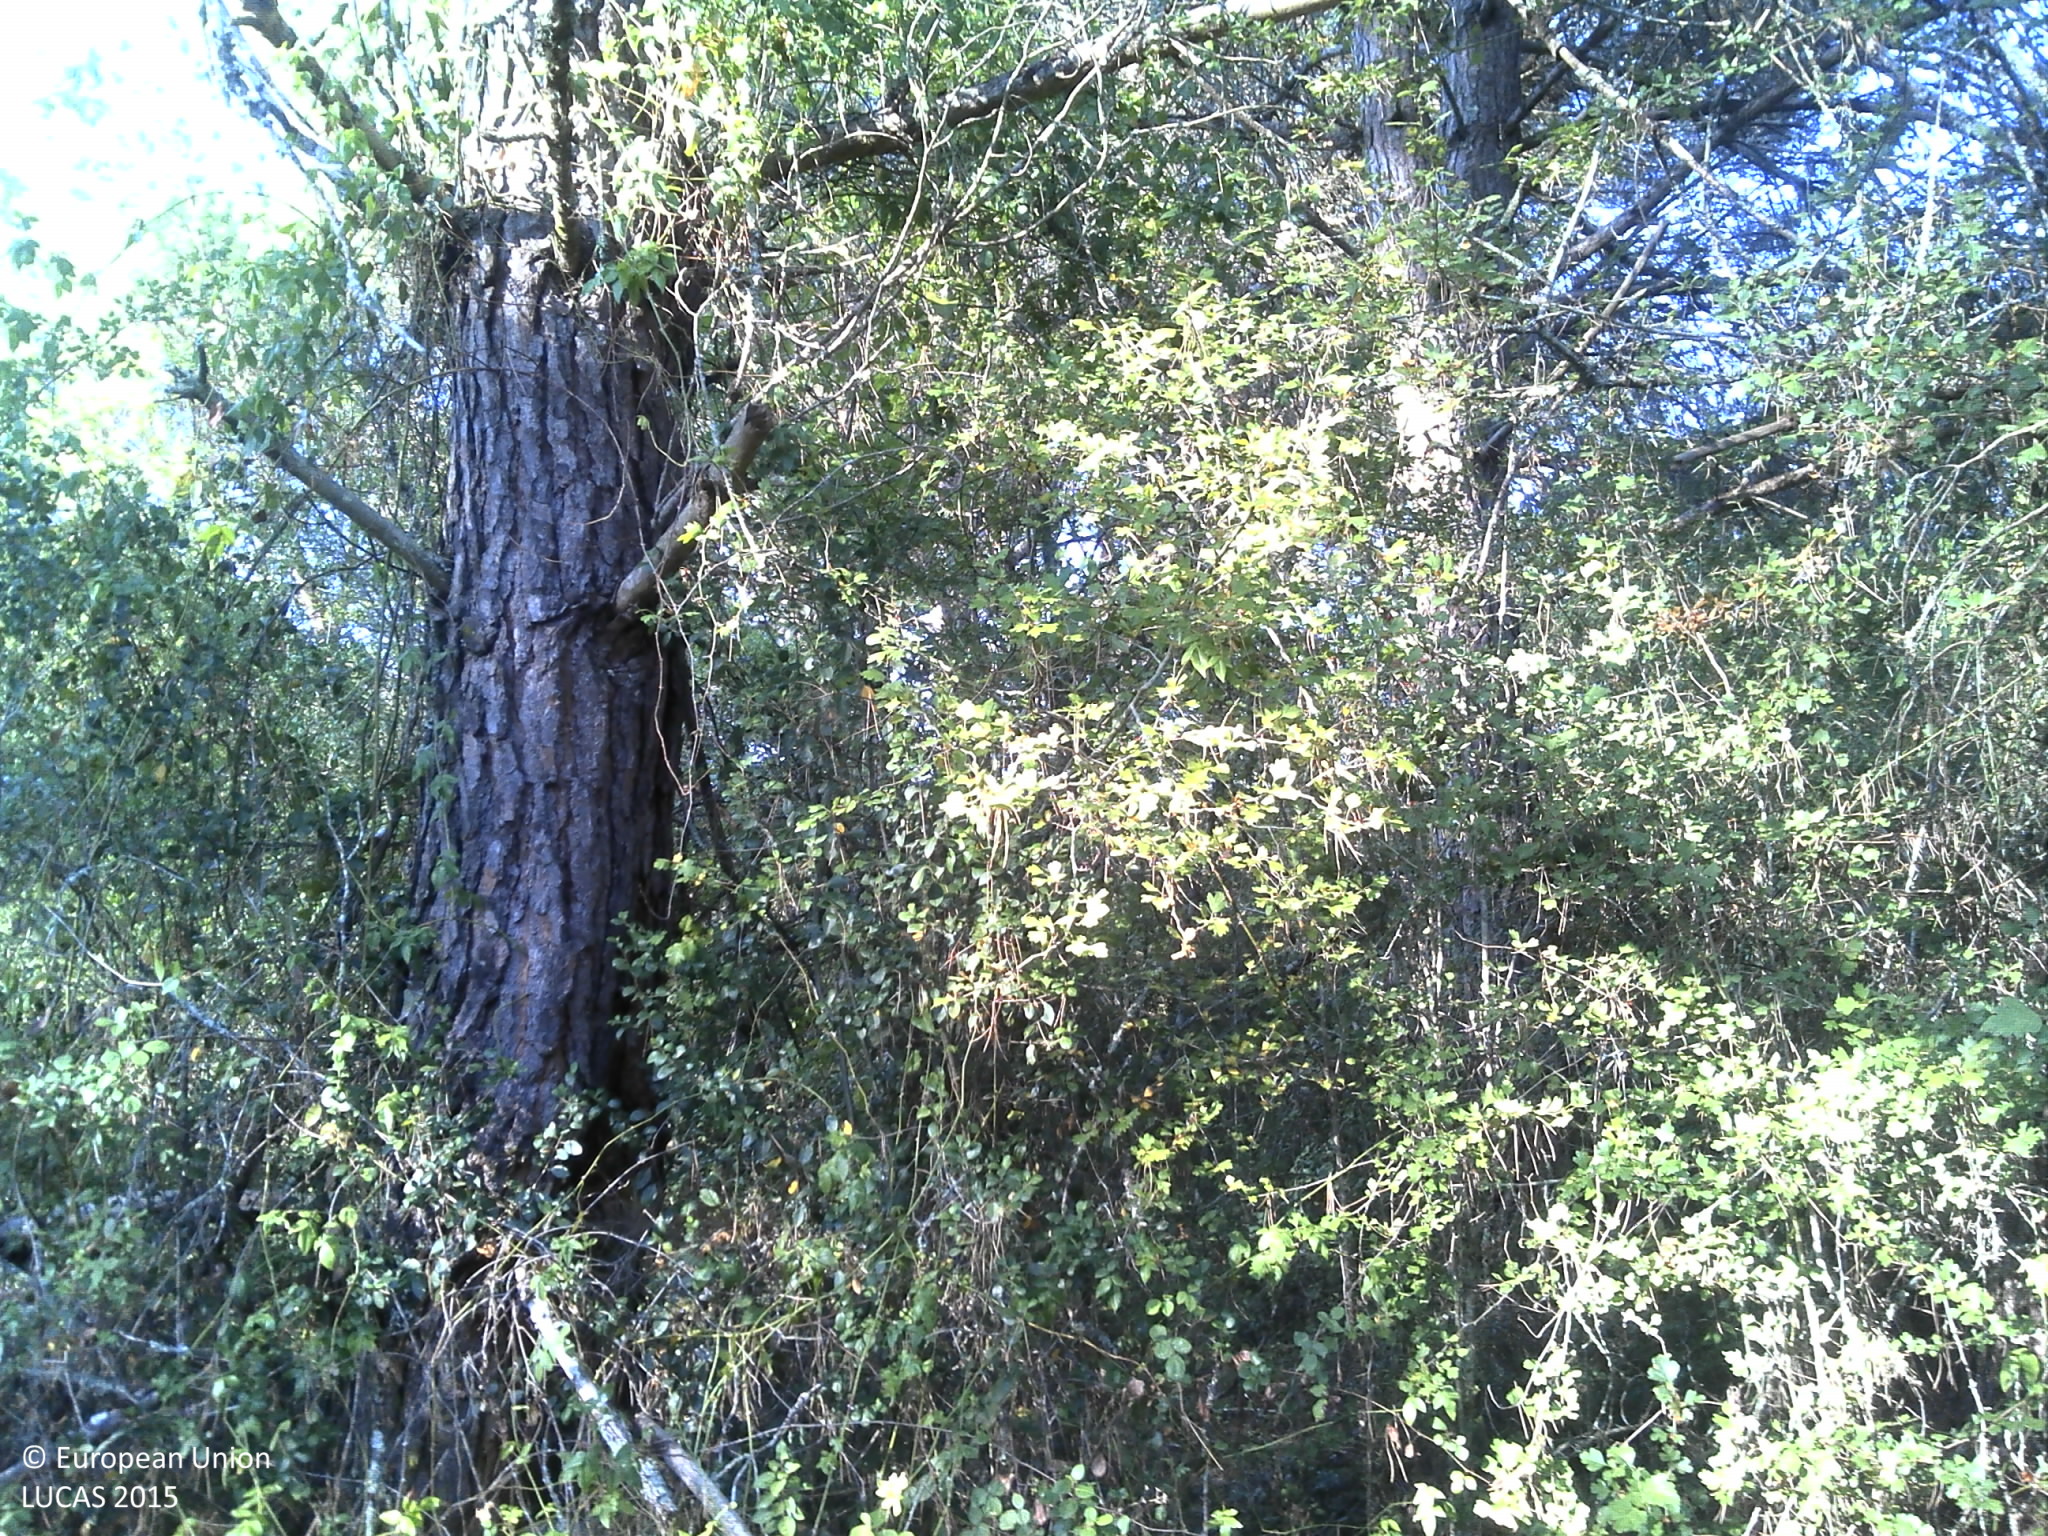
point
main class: Woodland
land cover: Pine dominated mixed woodland
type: coniferous forest of the mediterranean region
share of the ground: 50 - 75 %
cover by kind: coniferous forest trees 40 %, broadleaved forest trees 20 %, shrubs 20 %, unconsolidated bare surface 5 %
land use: Forestry
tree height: > 5 m
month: July
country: PT
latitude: 40.0758
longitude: -8.6260
